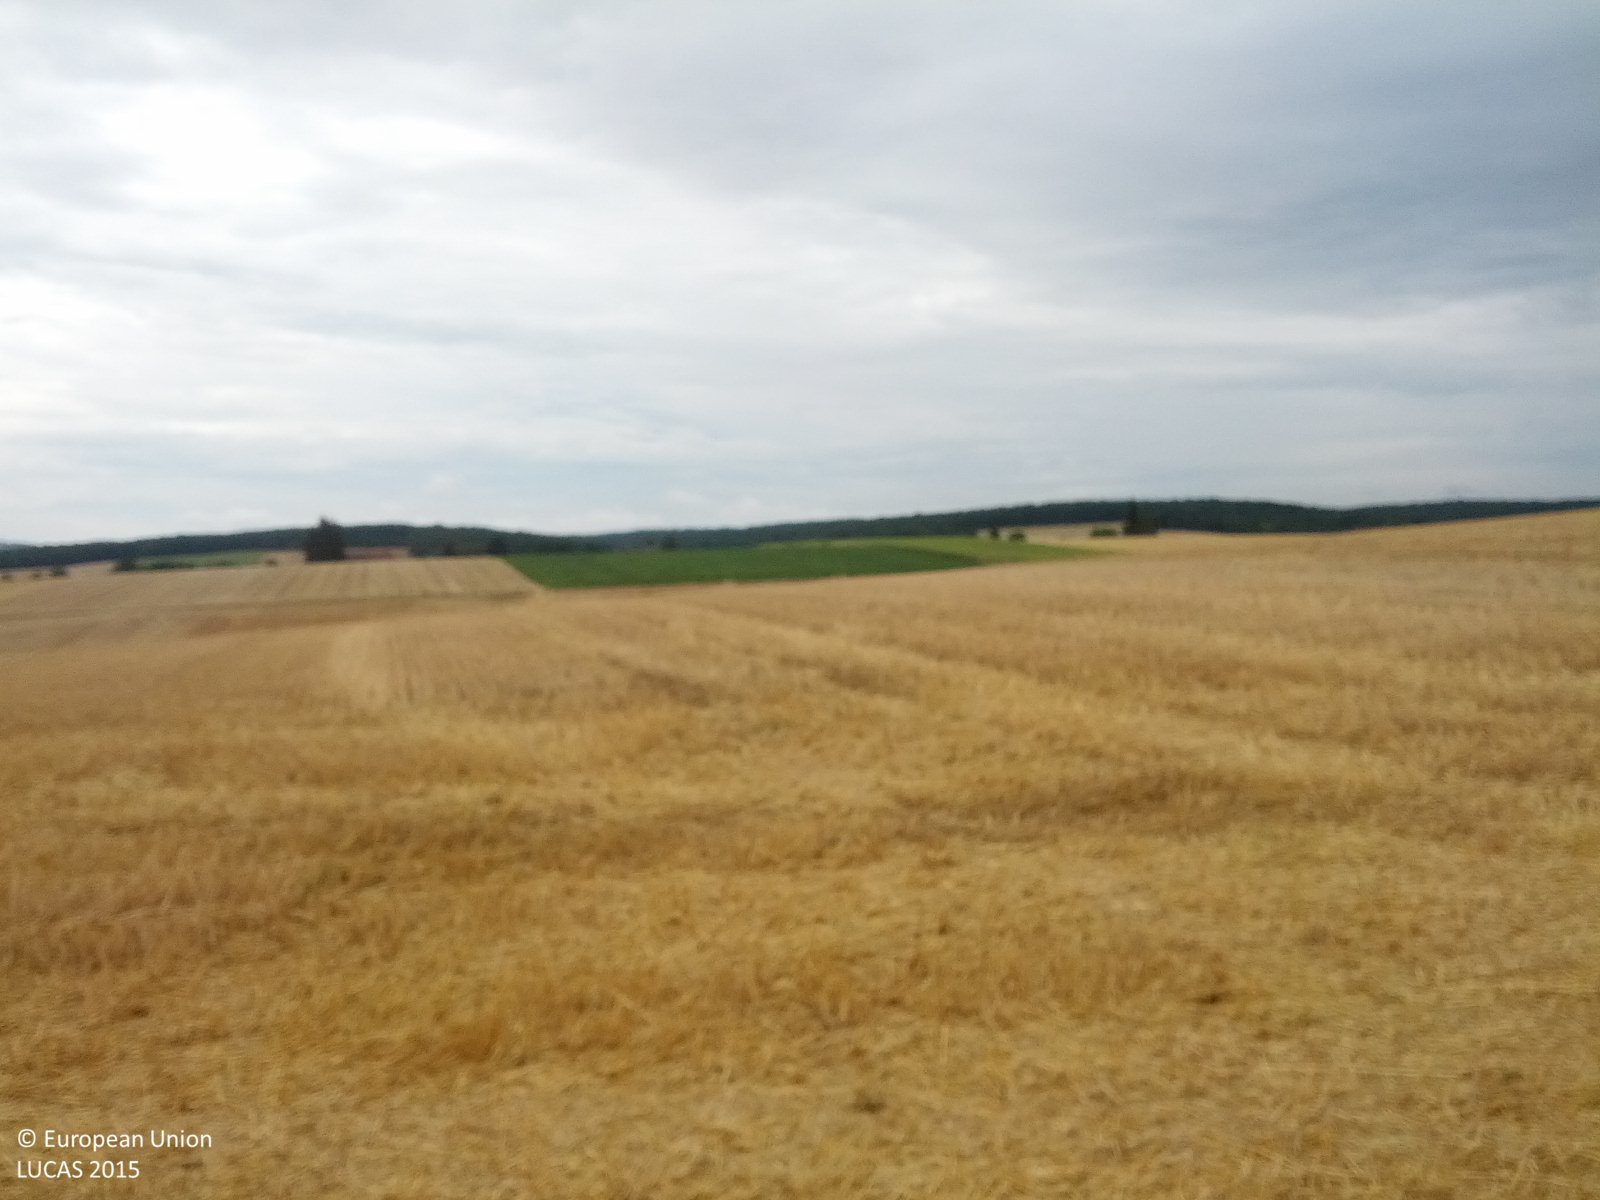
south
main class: Cropland
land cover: Common wheat
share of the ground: 10 - 25 %
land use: Agriculture (excluding fallow land and kitchen gardens)
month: July
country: AT
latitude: 48.6185
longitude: 16.3406
